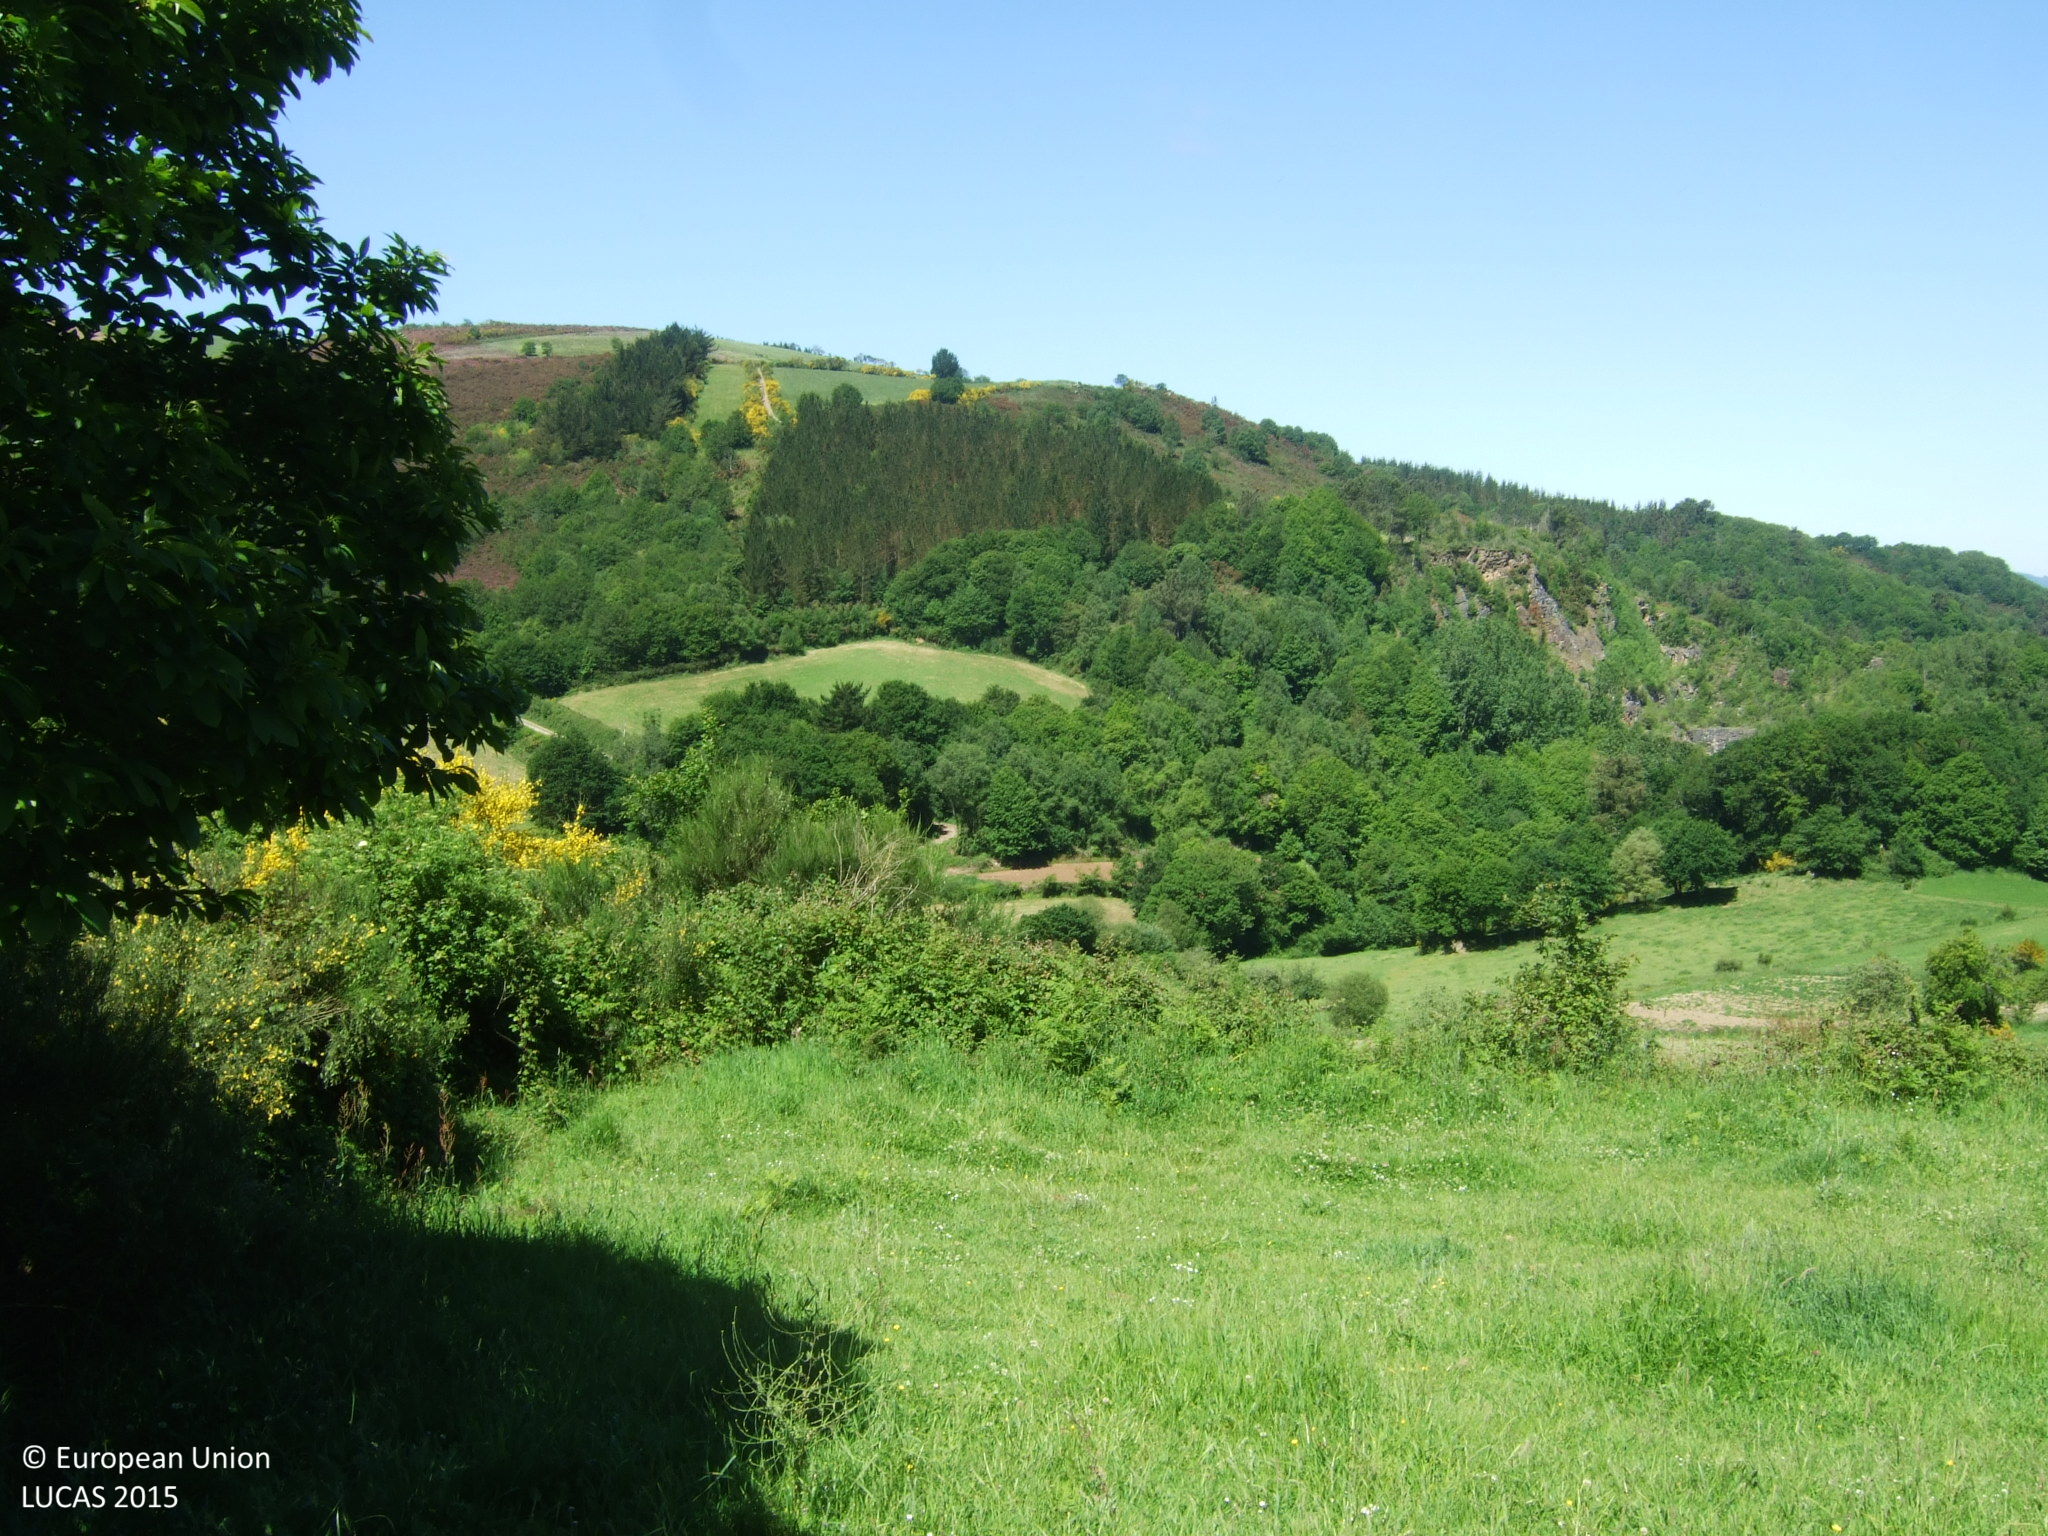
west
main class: Grassland
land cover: Grassland without tree/shrub cover
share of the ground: > 75 %
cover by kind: herbaceous plants 100 %
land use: Agriculture (excluding fallow land and kitchen gardens)
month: May
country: ES
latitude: 42.7430
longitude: -7.5799
